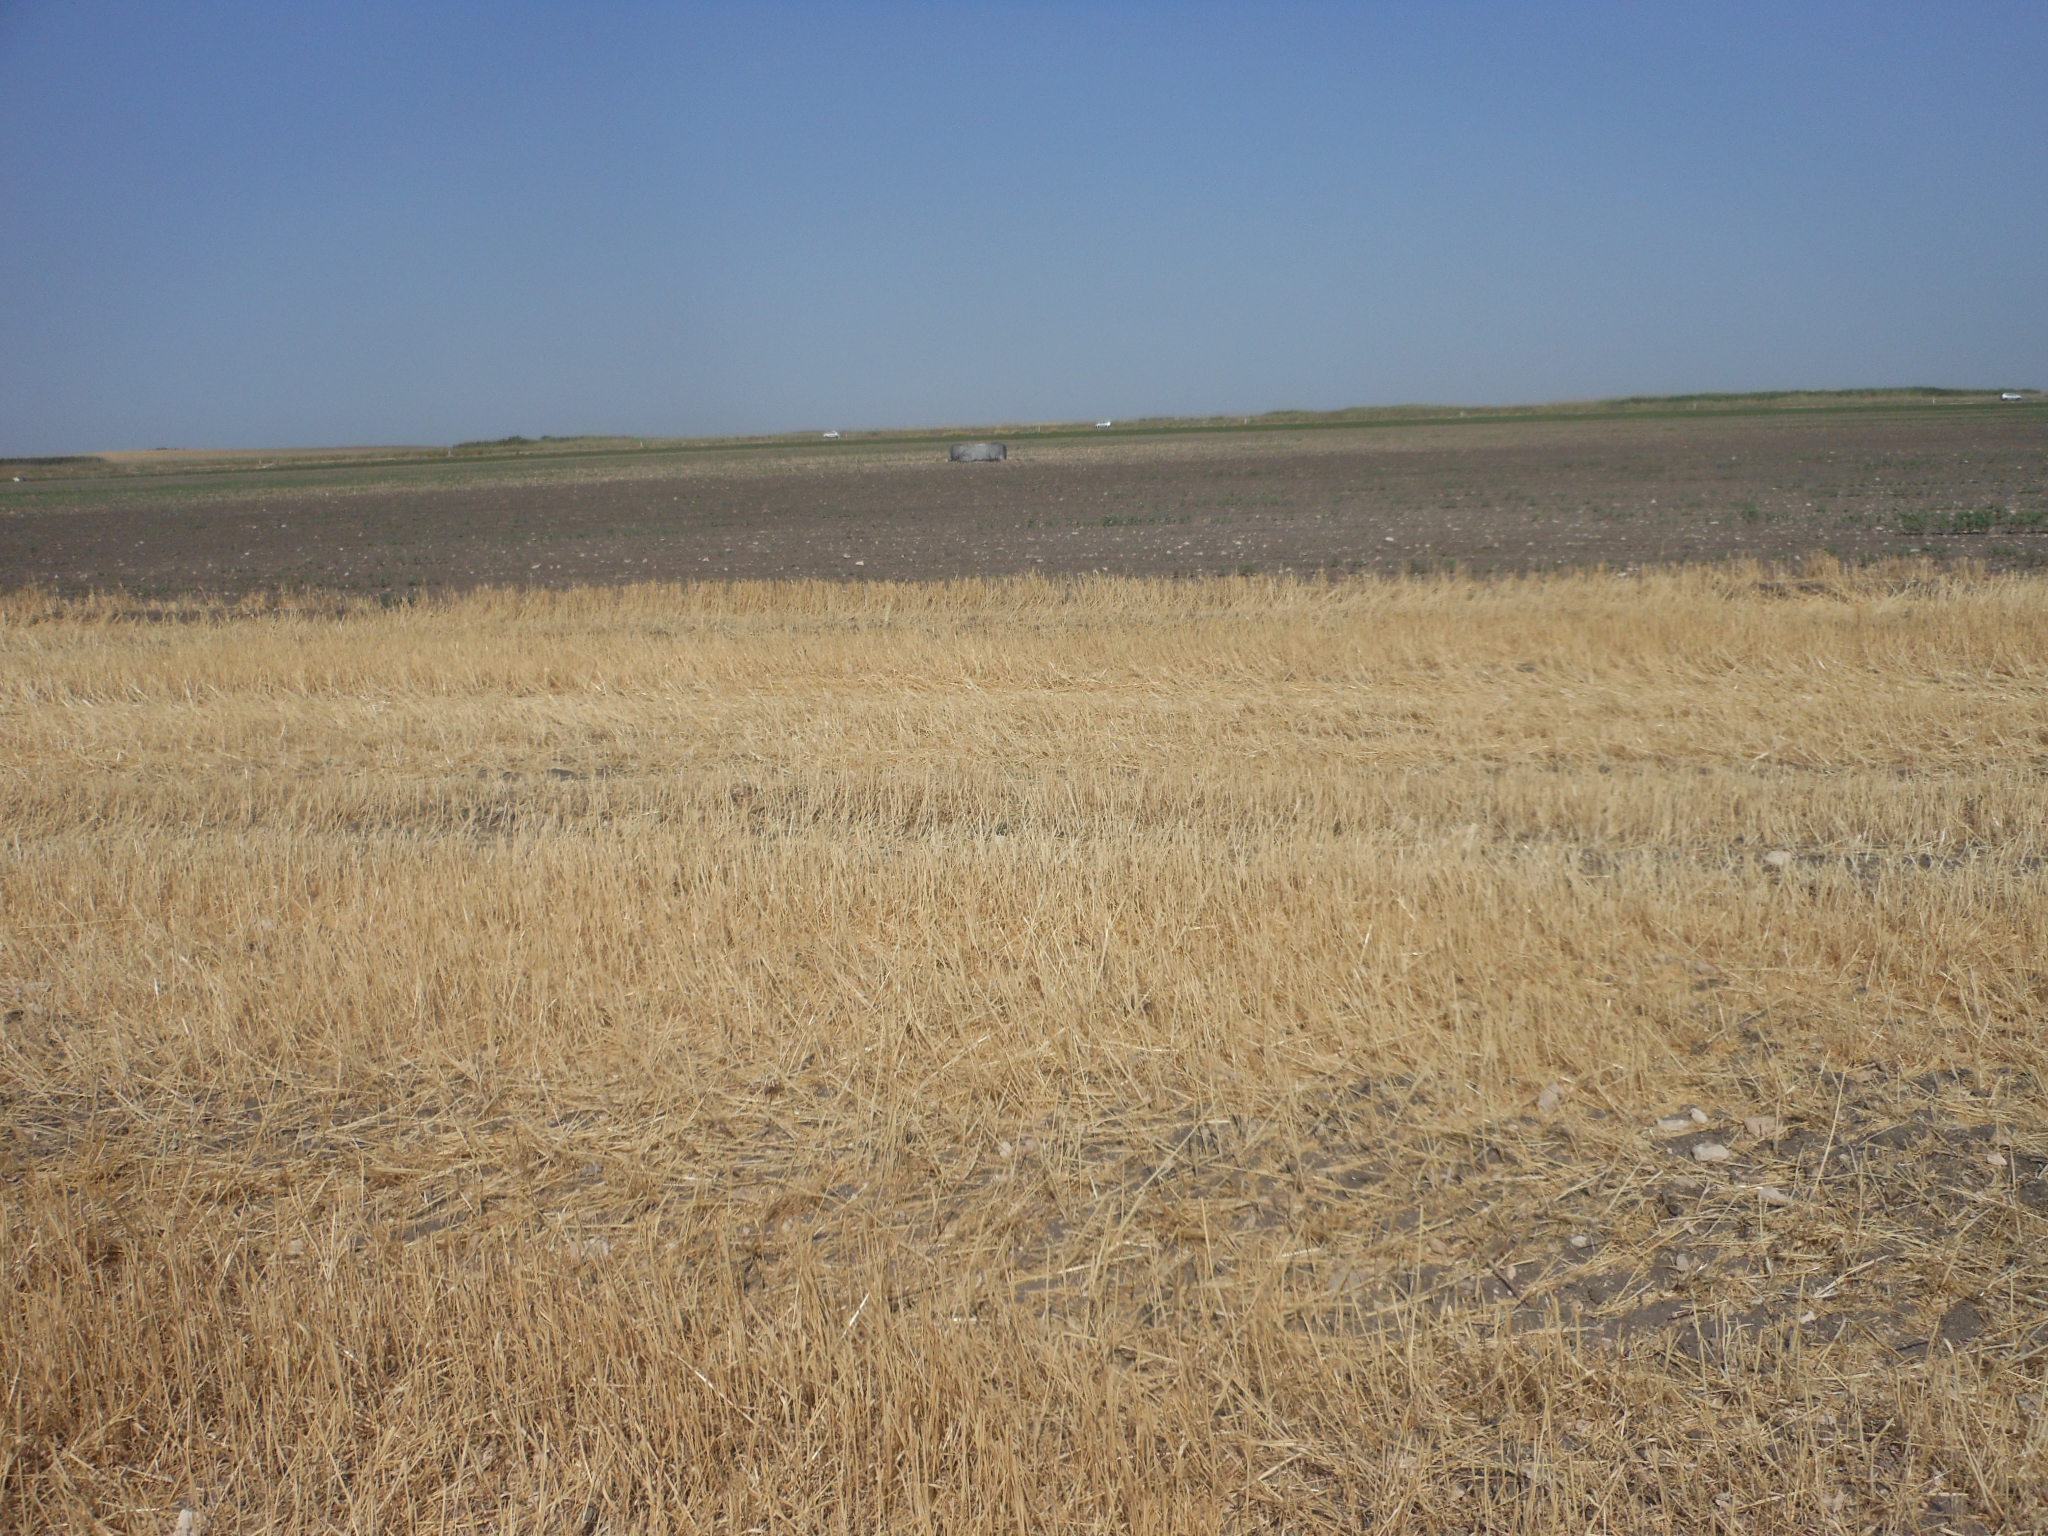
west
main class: Cropland
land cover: Common wheat
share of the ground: < 10 %
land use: Agriculture (excluding fallow land and kitchen gardens)
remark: Harvested field
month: June
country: ES
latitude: 37.3226
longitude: -5.1197
